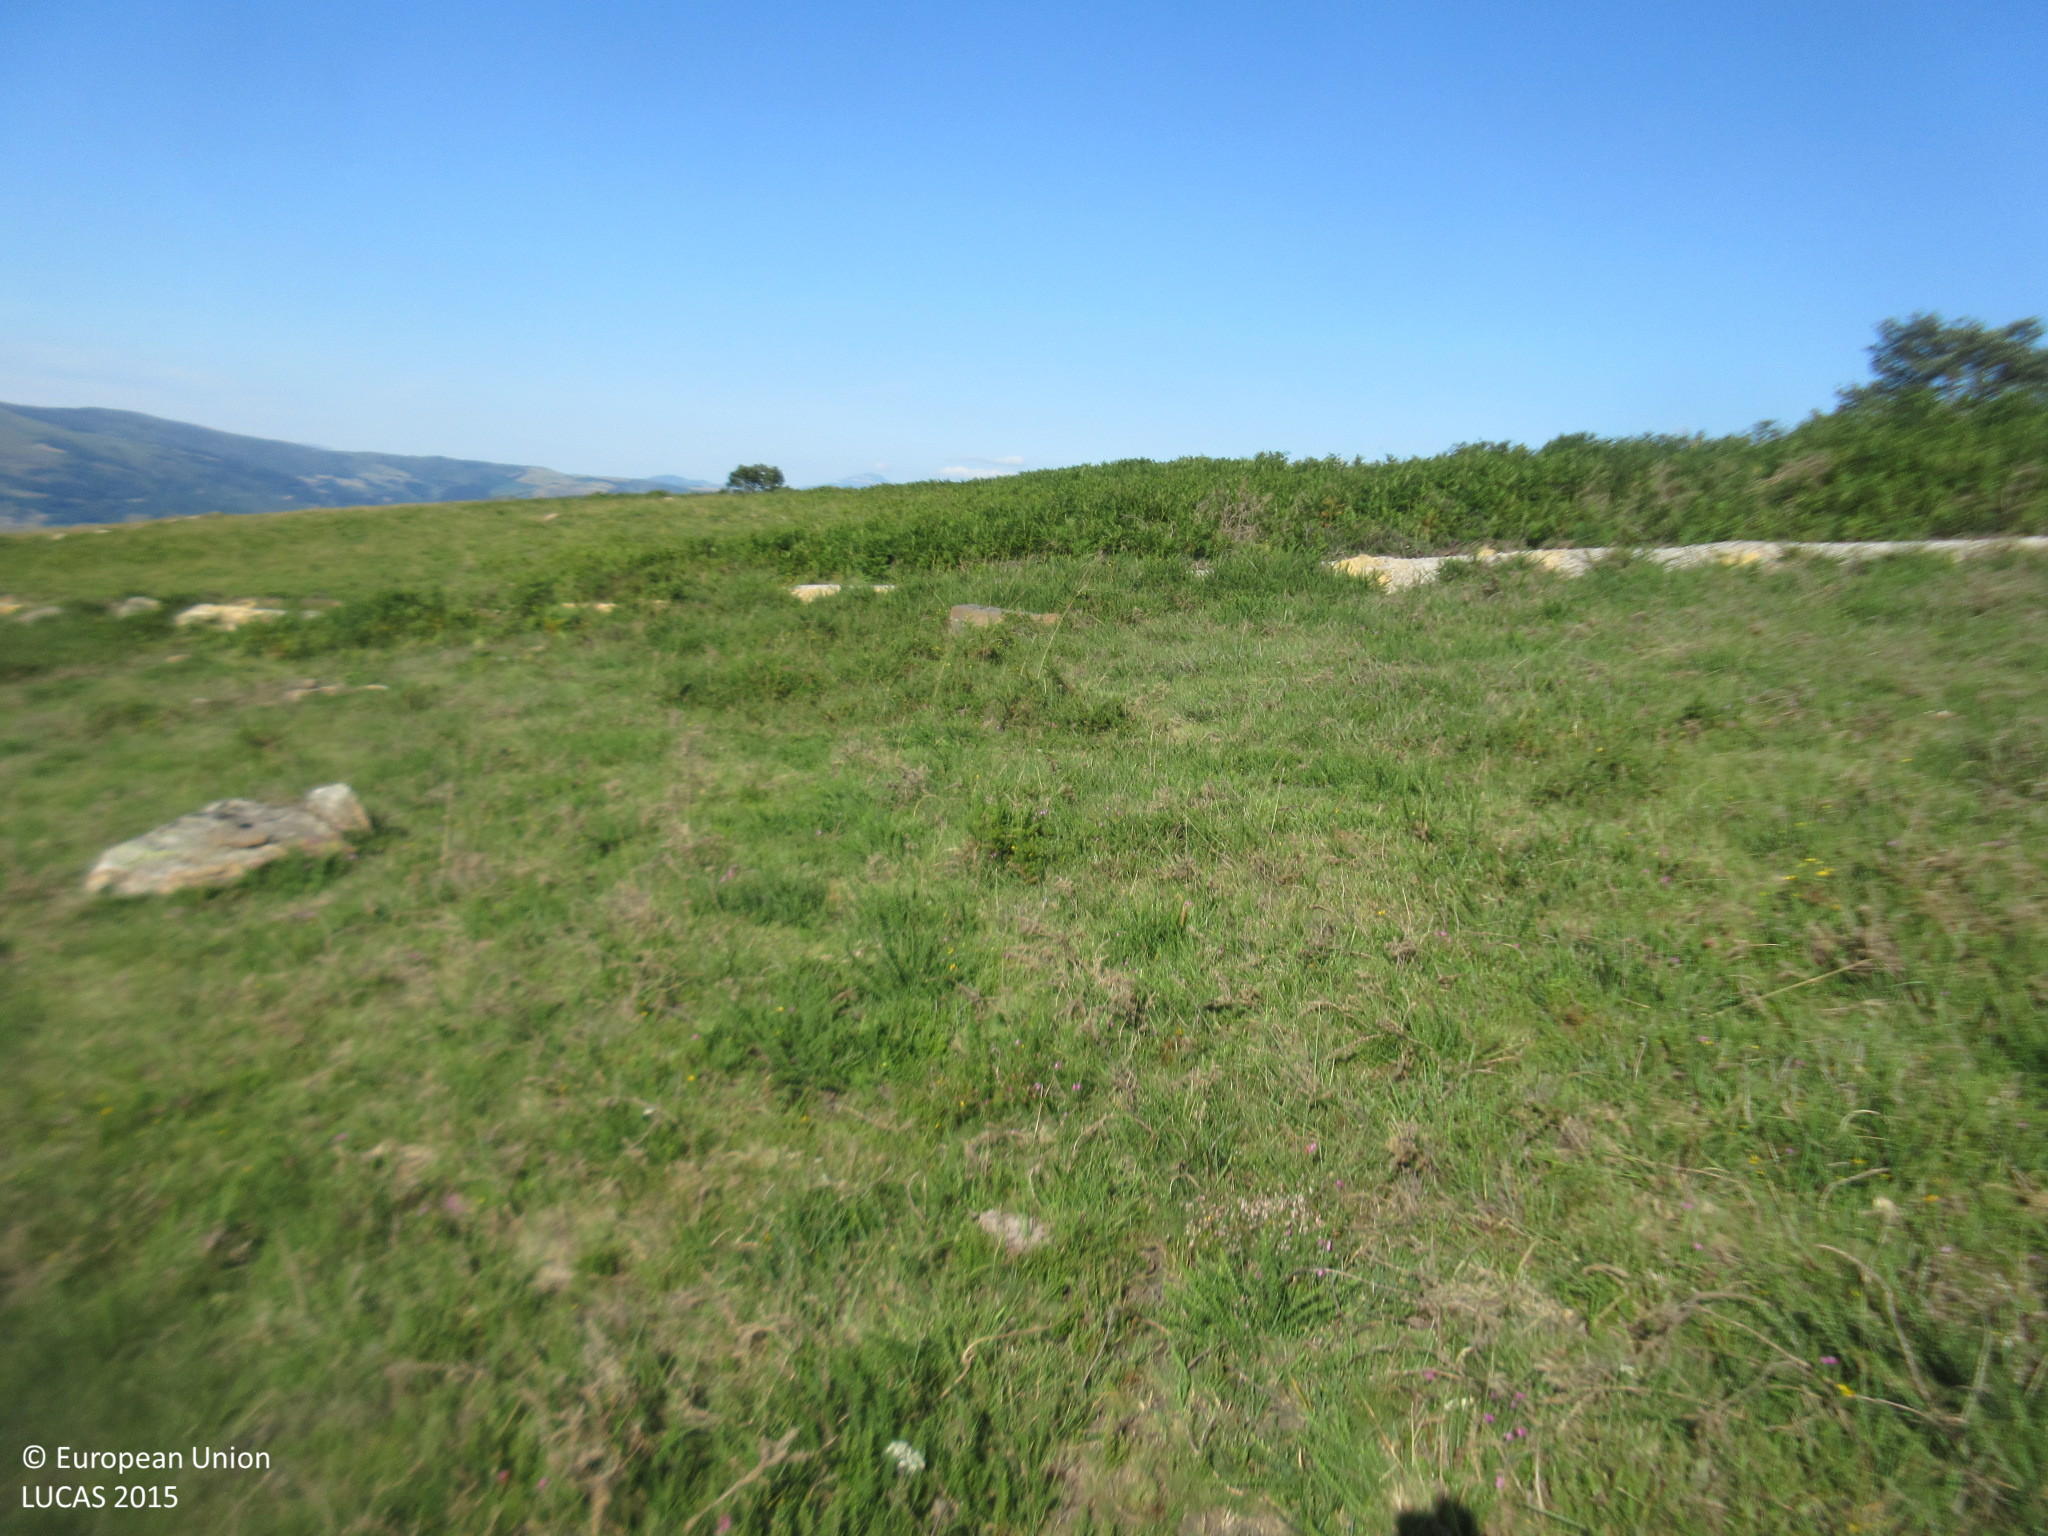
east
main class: Shrubland
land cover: Shrubland without tree cover
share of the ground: > 75 %
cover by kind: shrubs 100 %
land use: Agriculture (excluding fallow land and kitchen gardens)
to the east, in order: Shrubland without tree cover; Tracks; Shrubland without tree cover; Fences; Grassland without tree/shrub cover
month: July
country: ES
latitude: 43.1318
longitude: -3.9268
